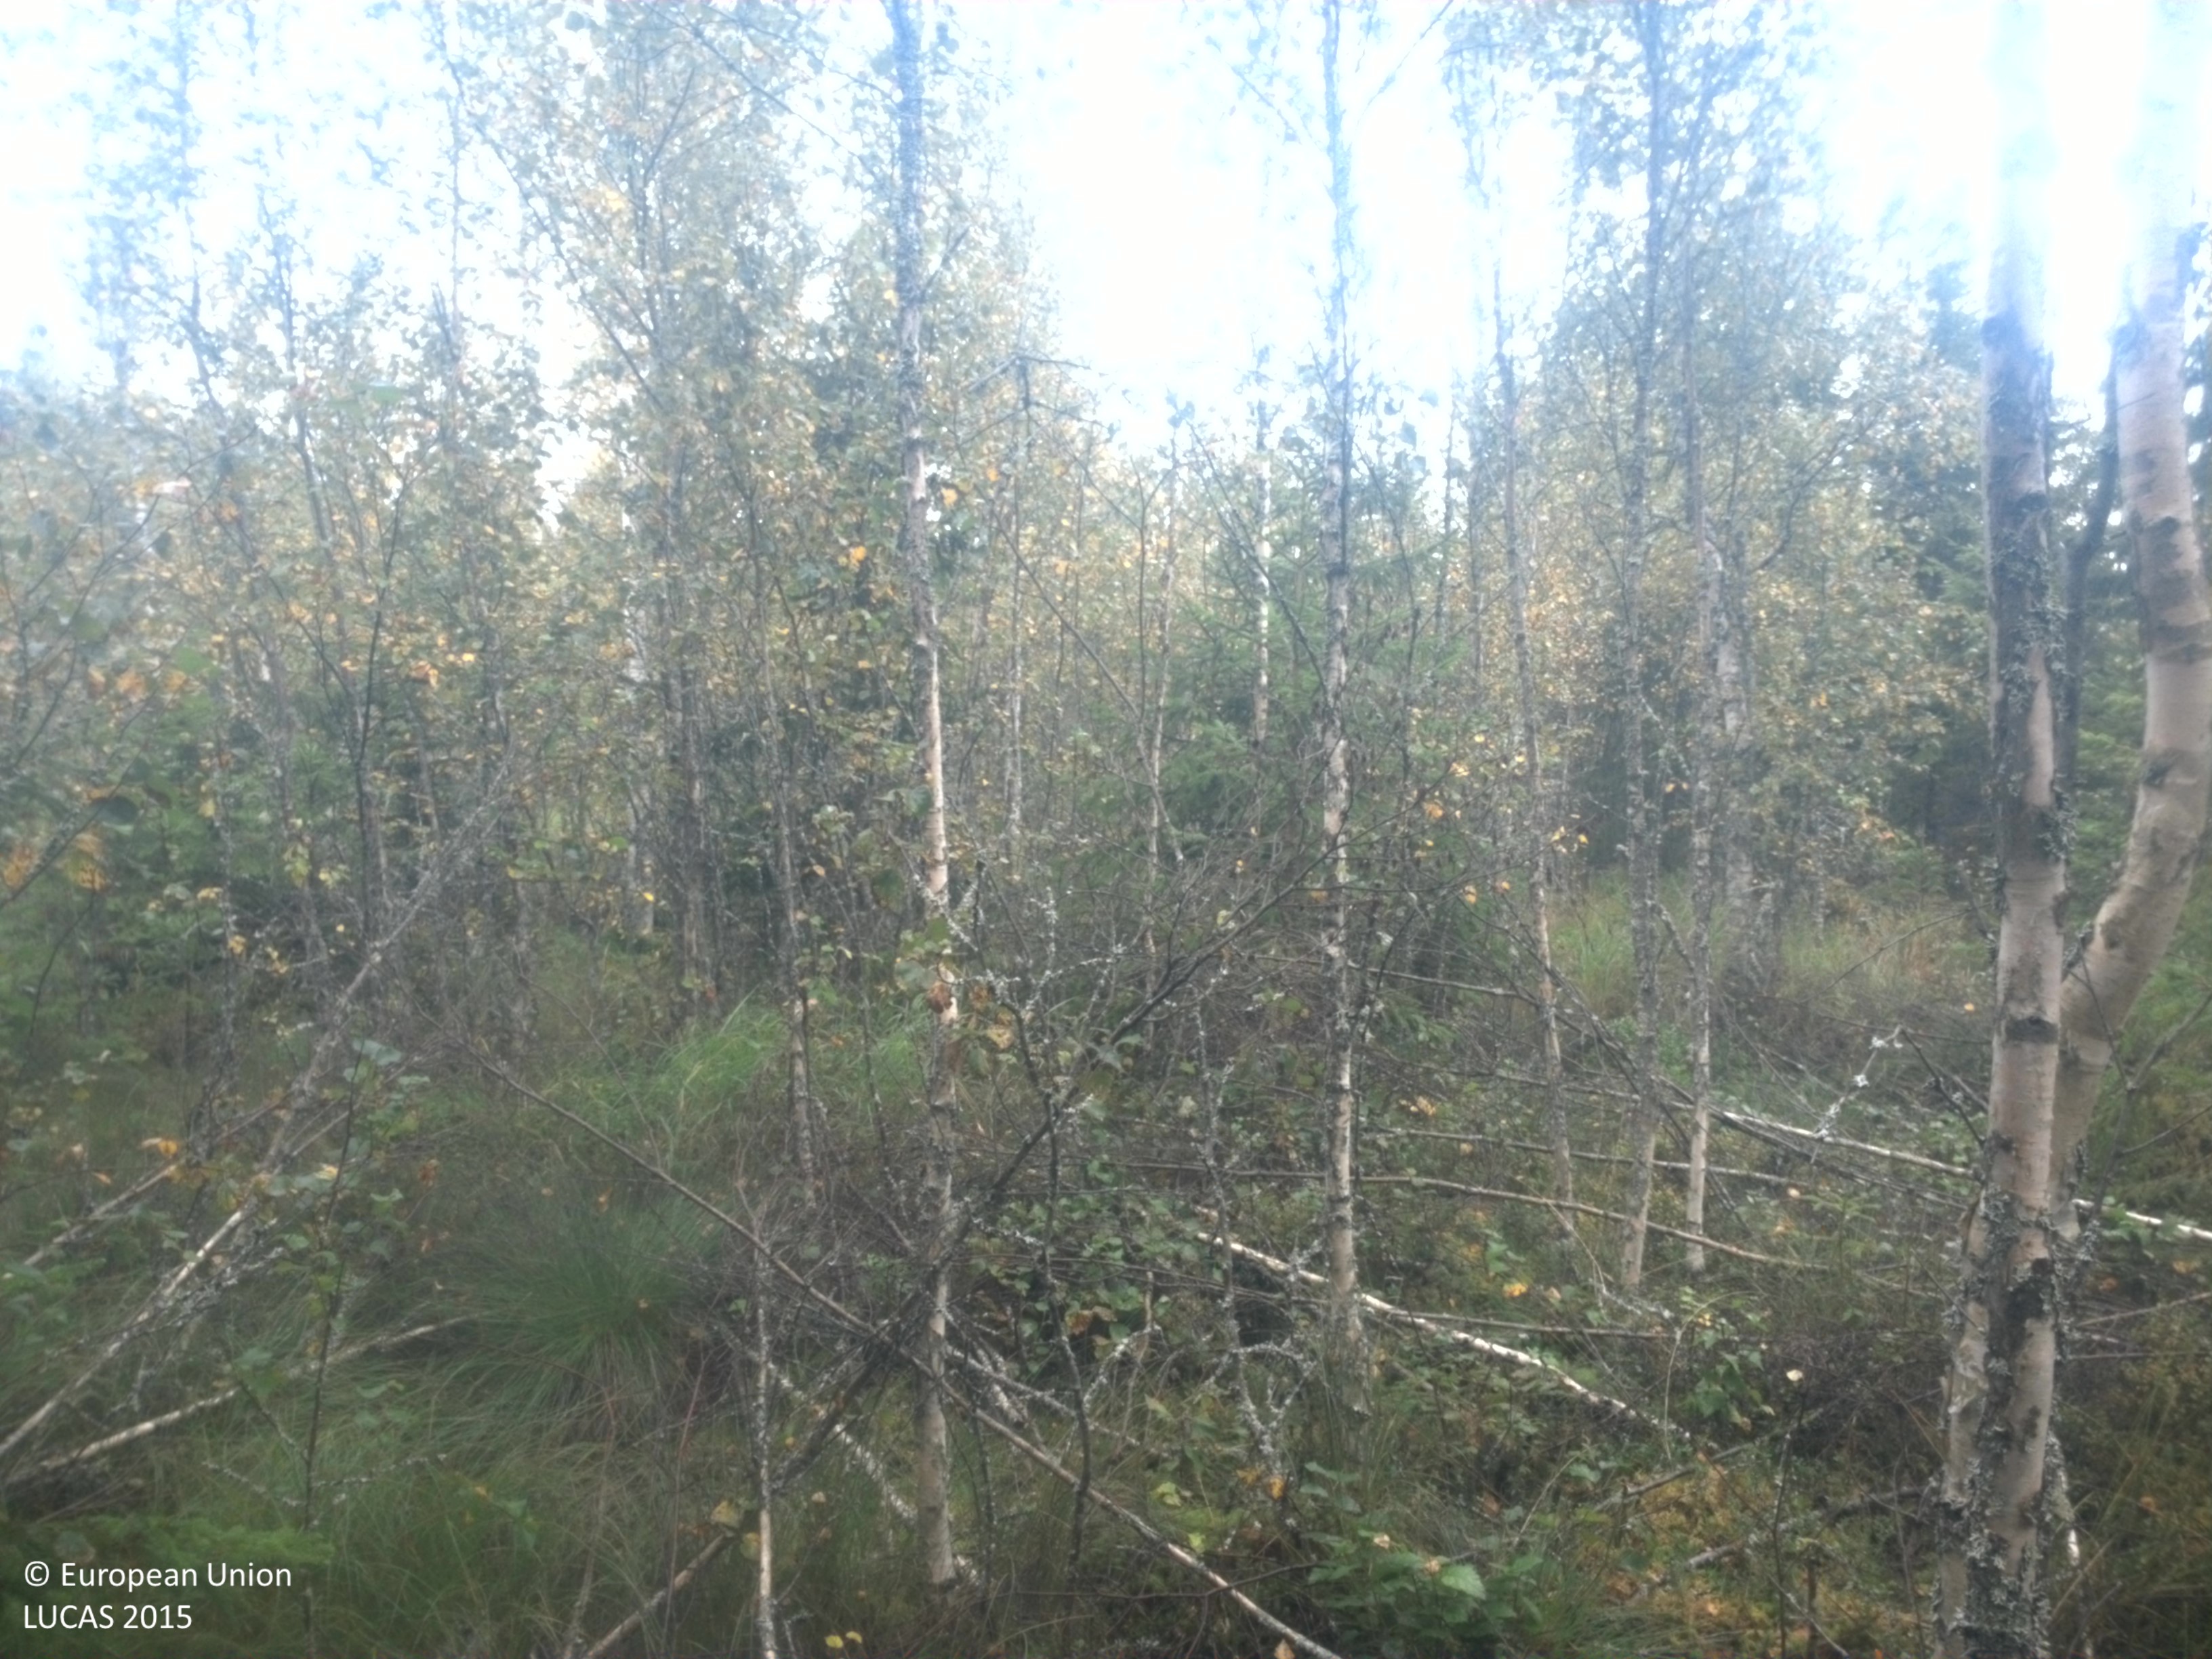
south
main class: Woodland
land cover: Spruce dominated mixed woodland
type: boreal forest
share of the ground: 50 - 75 %
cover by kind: coniferous forest trees 30 %, broadleaved forest trees 20 %, shrubs 20 %, lichens and mosses 20 %, herbaceous plants 10 %
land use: Forestry
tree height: > 5 m
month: September
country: SE
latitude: 58.8795
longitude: 14.0345
